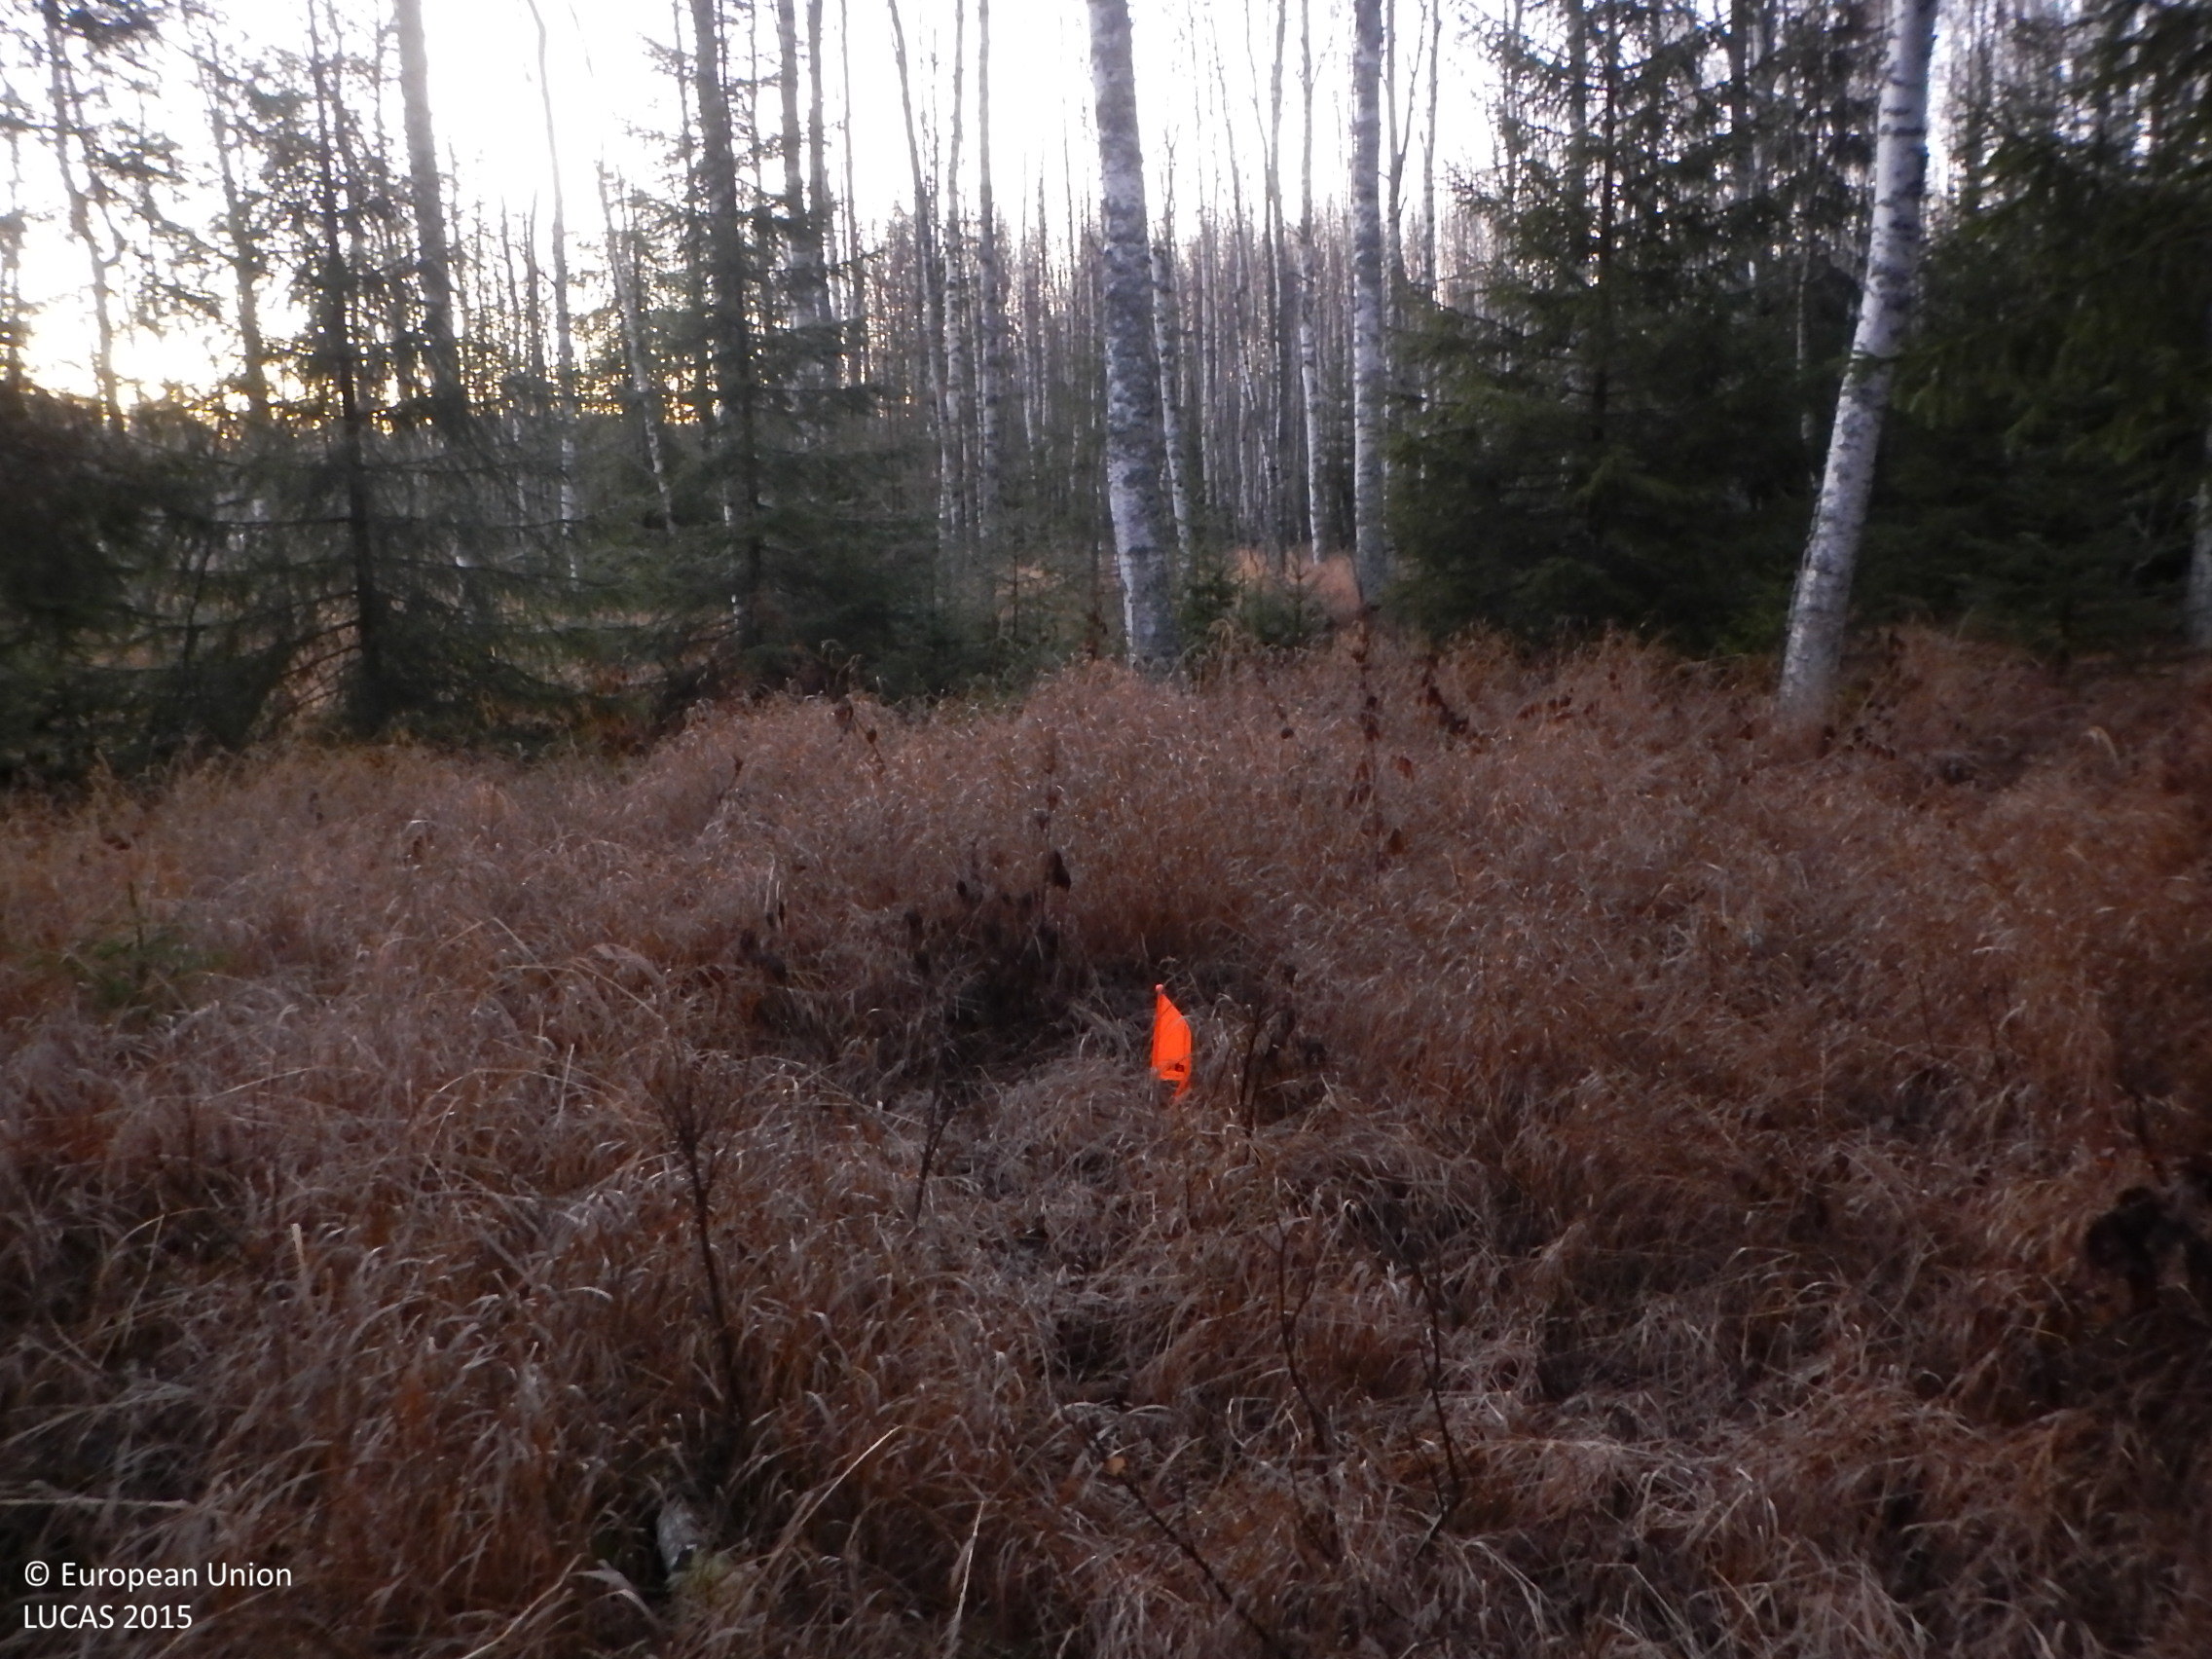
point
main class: Woodland
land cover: Spruce dominated mixed woodland
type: boreal forest
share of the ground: 50 - 75 %
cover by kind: coniferous forest trees 30 %, broadleaved forest trees 30 %, herbaceous plants 30 %, shrubs 10 %
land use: Forestry
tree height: > 5 m
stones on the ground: < 10 %
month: November
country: SE
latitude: 61.4035
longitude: 16.1086
